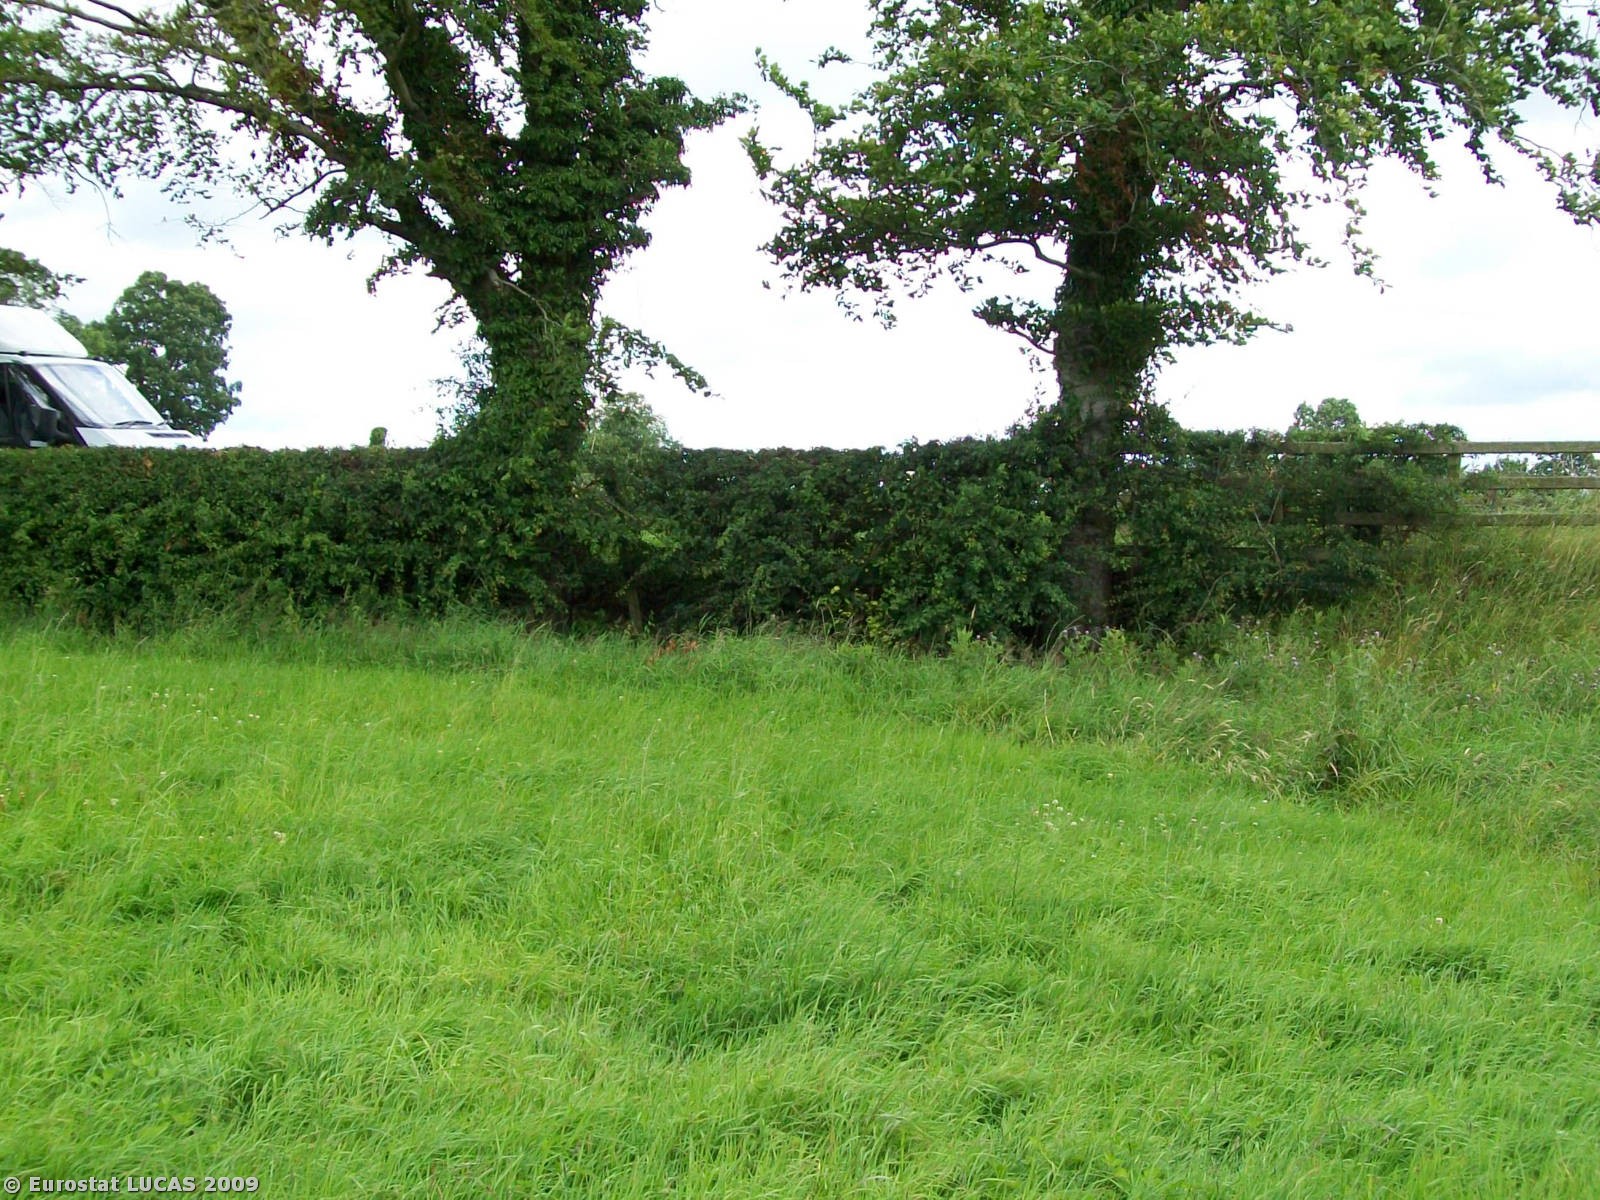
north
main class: Grassland
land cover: Grassland without tree/shrub cover
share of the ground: > 75 %
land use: Agriculture (excluding fallow land and kitchen gardens)
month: July
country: GB
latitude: 54.6272
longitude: -6.6559
